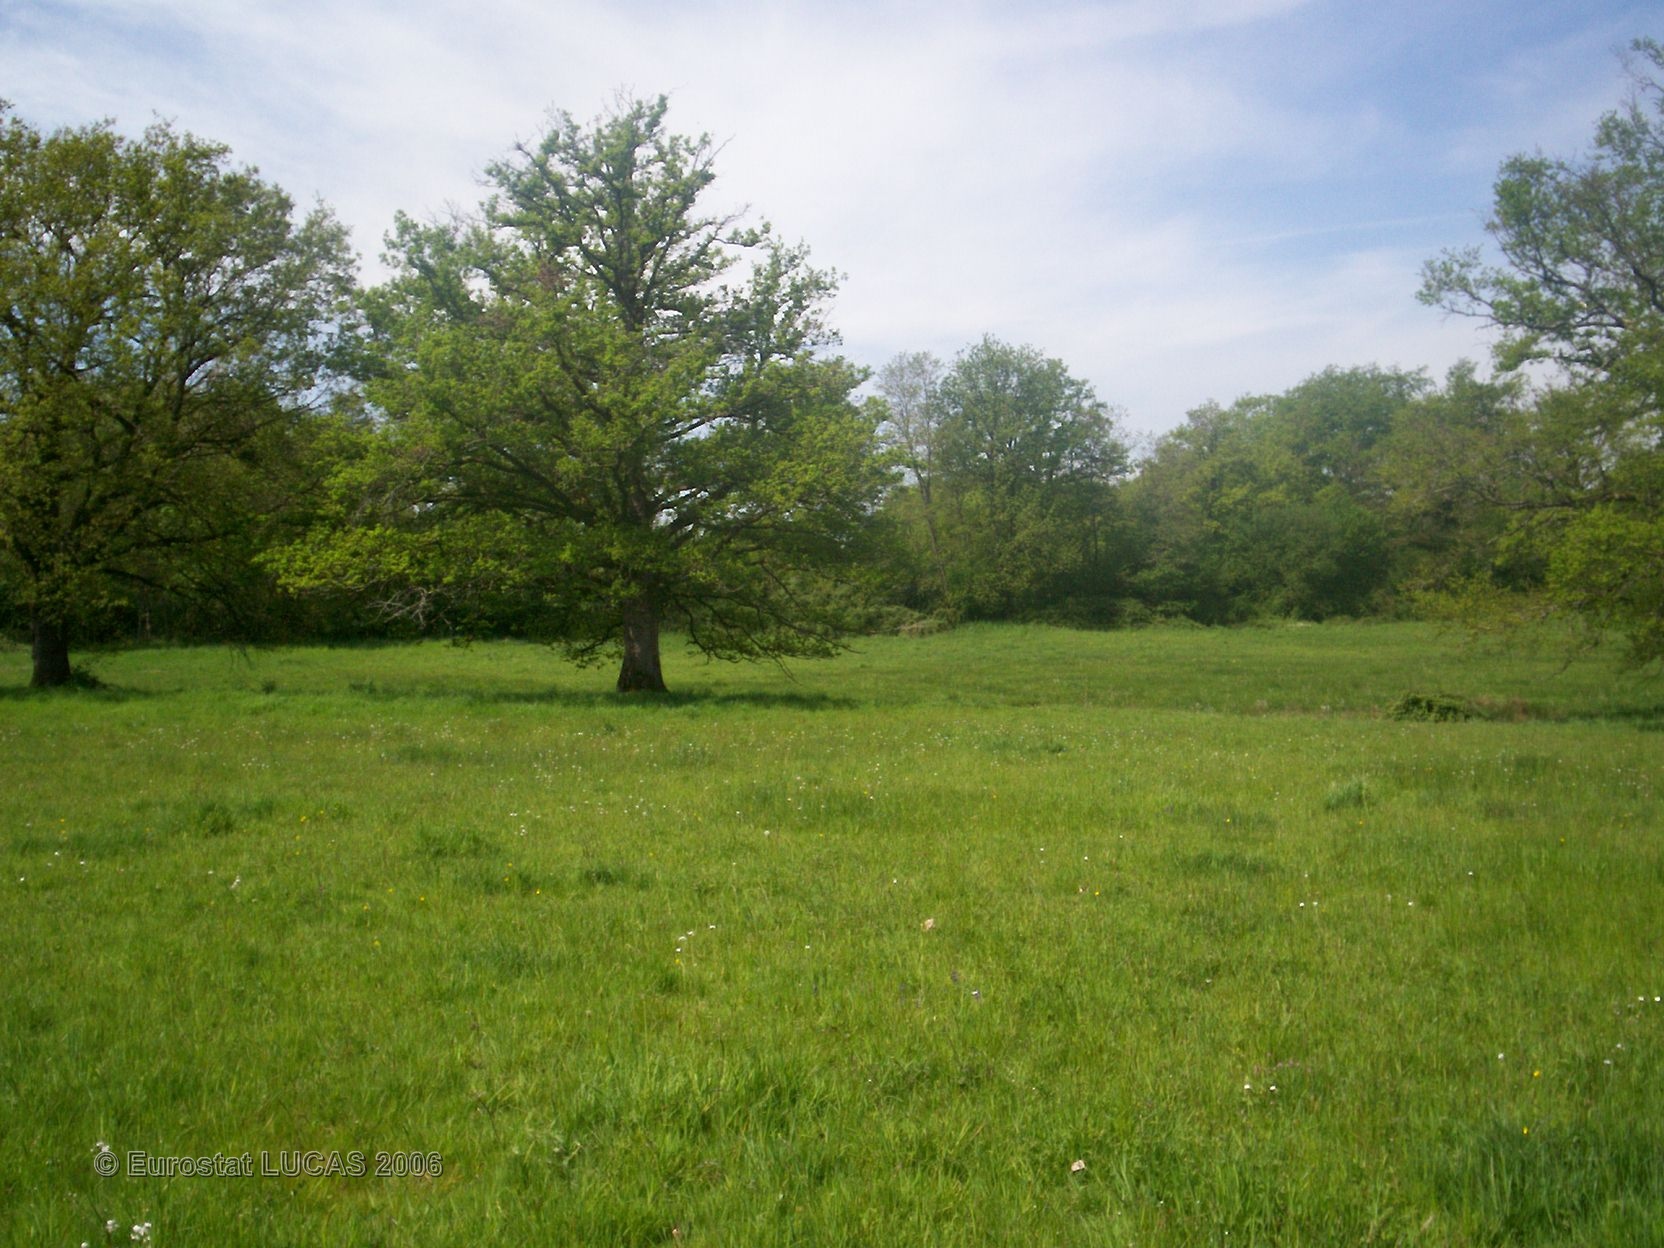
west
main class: Grassland
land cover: Grassland without tree/shrub cover
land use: Agriculture (excluding fallow land and kitchen gardens)
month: May
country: FR
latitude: 45.9619
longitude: 0.6828
